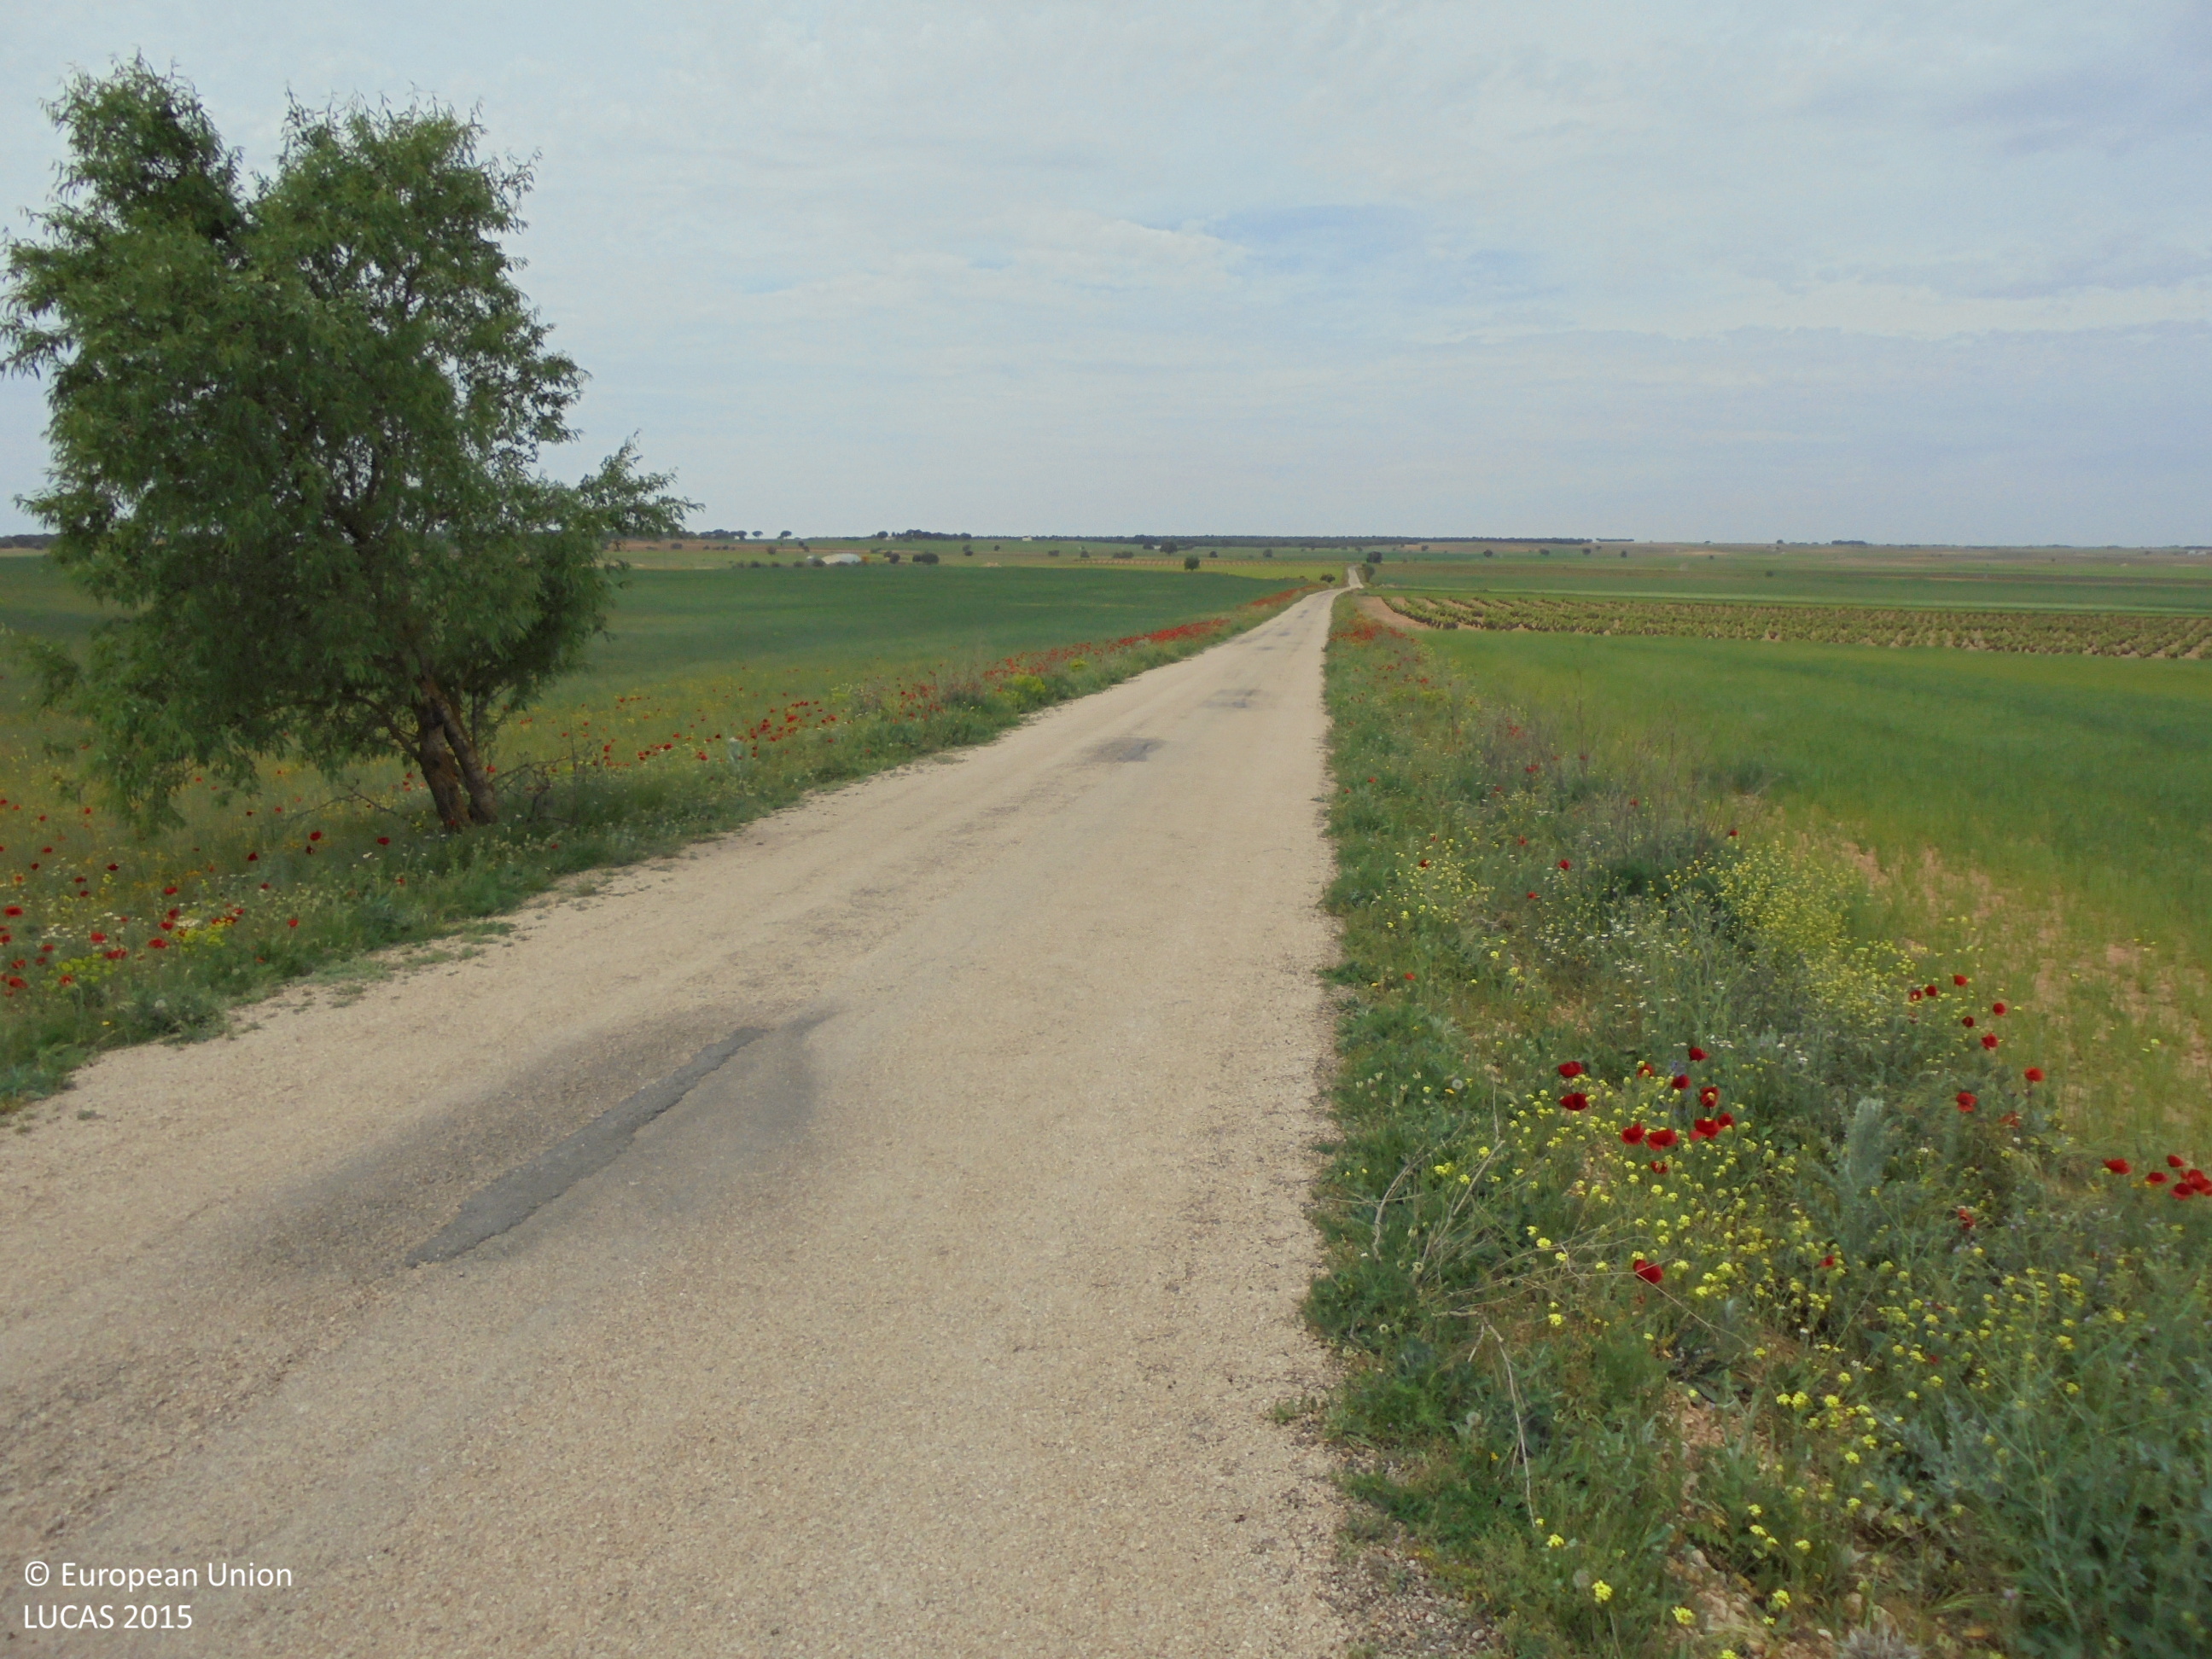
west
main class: Cropland
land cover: Barley
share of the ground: 25 - 50 %
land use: Agriculture (excluding fallow land and kitchen gardens)
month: May
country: ES
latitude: 39.2424
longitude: -1.6462
